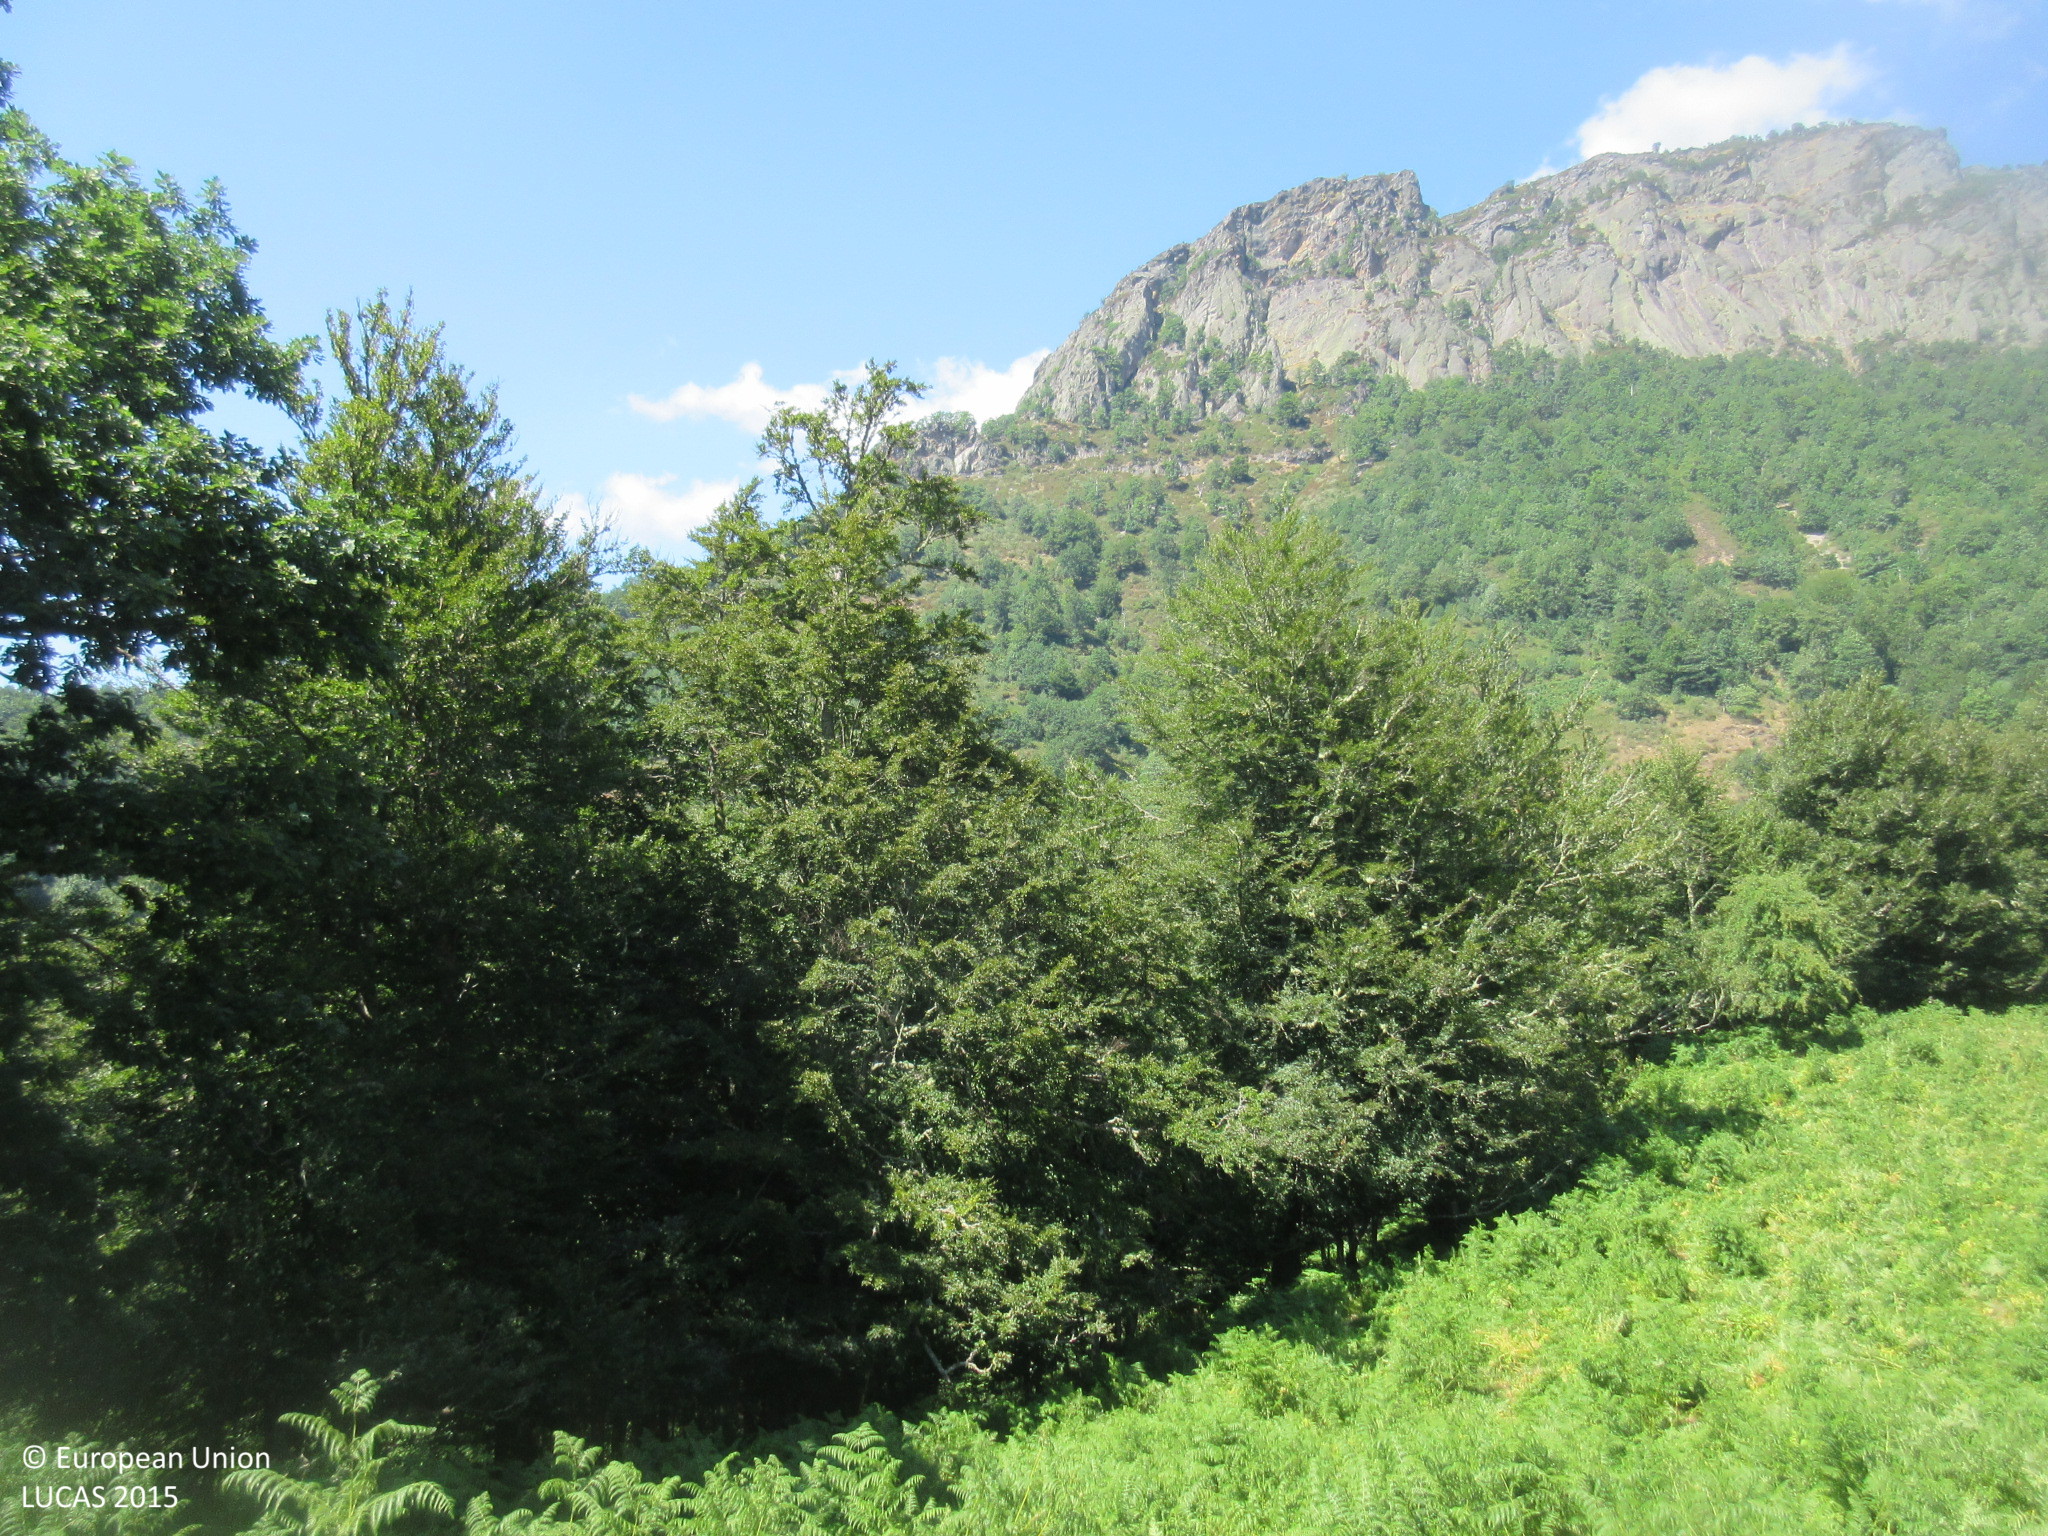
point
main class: Woodland
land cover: Broadleaved woodland
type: mountainous beech forest
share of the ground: > 75 %
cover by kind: broadleaved forest trees 100 %
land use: Forestry
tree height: > 5 m
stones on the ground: < 10 %
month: July
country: ES
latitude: 43.1244
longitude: -5.0015
